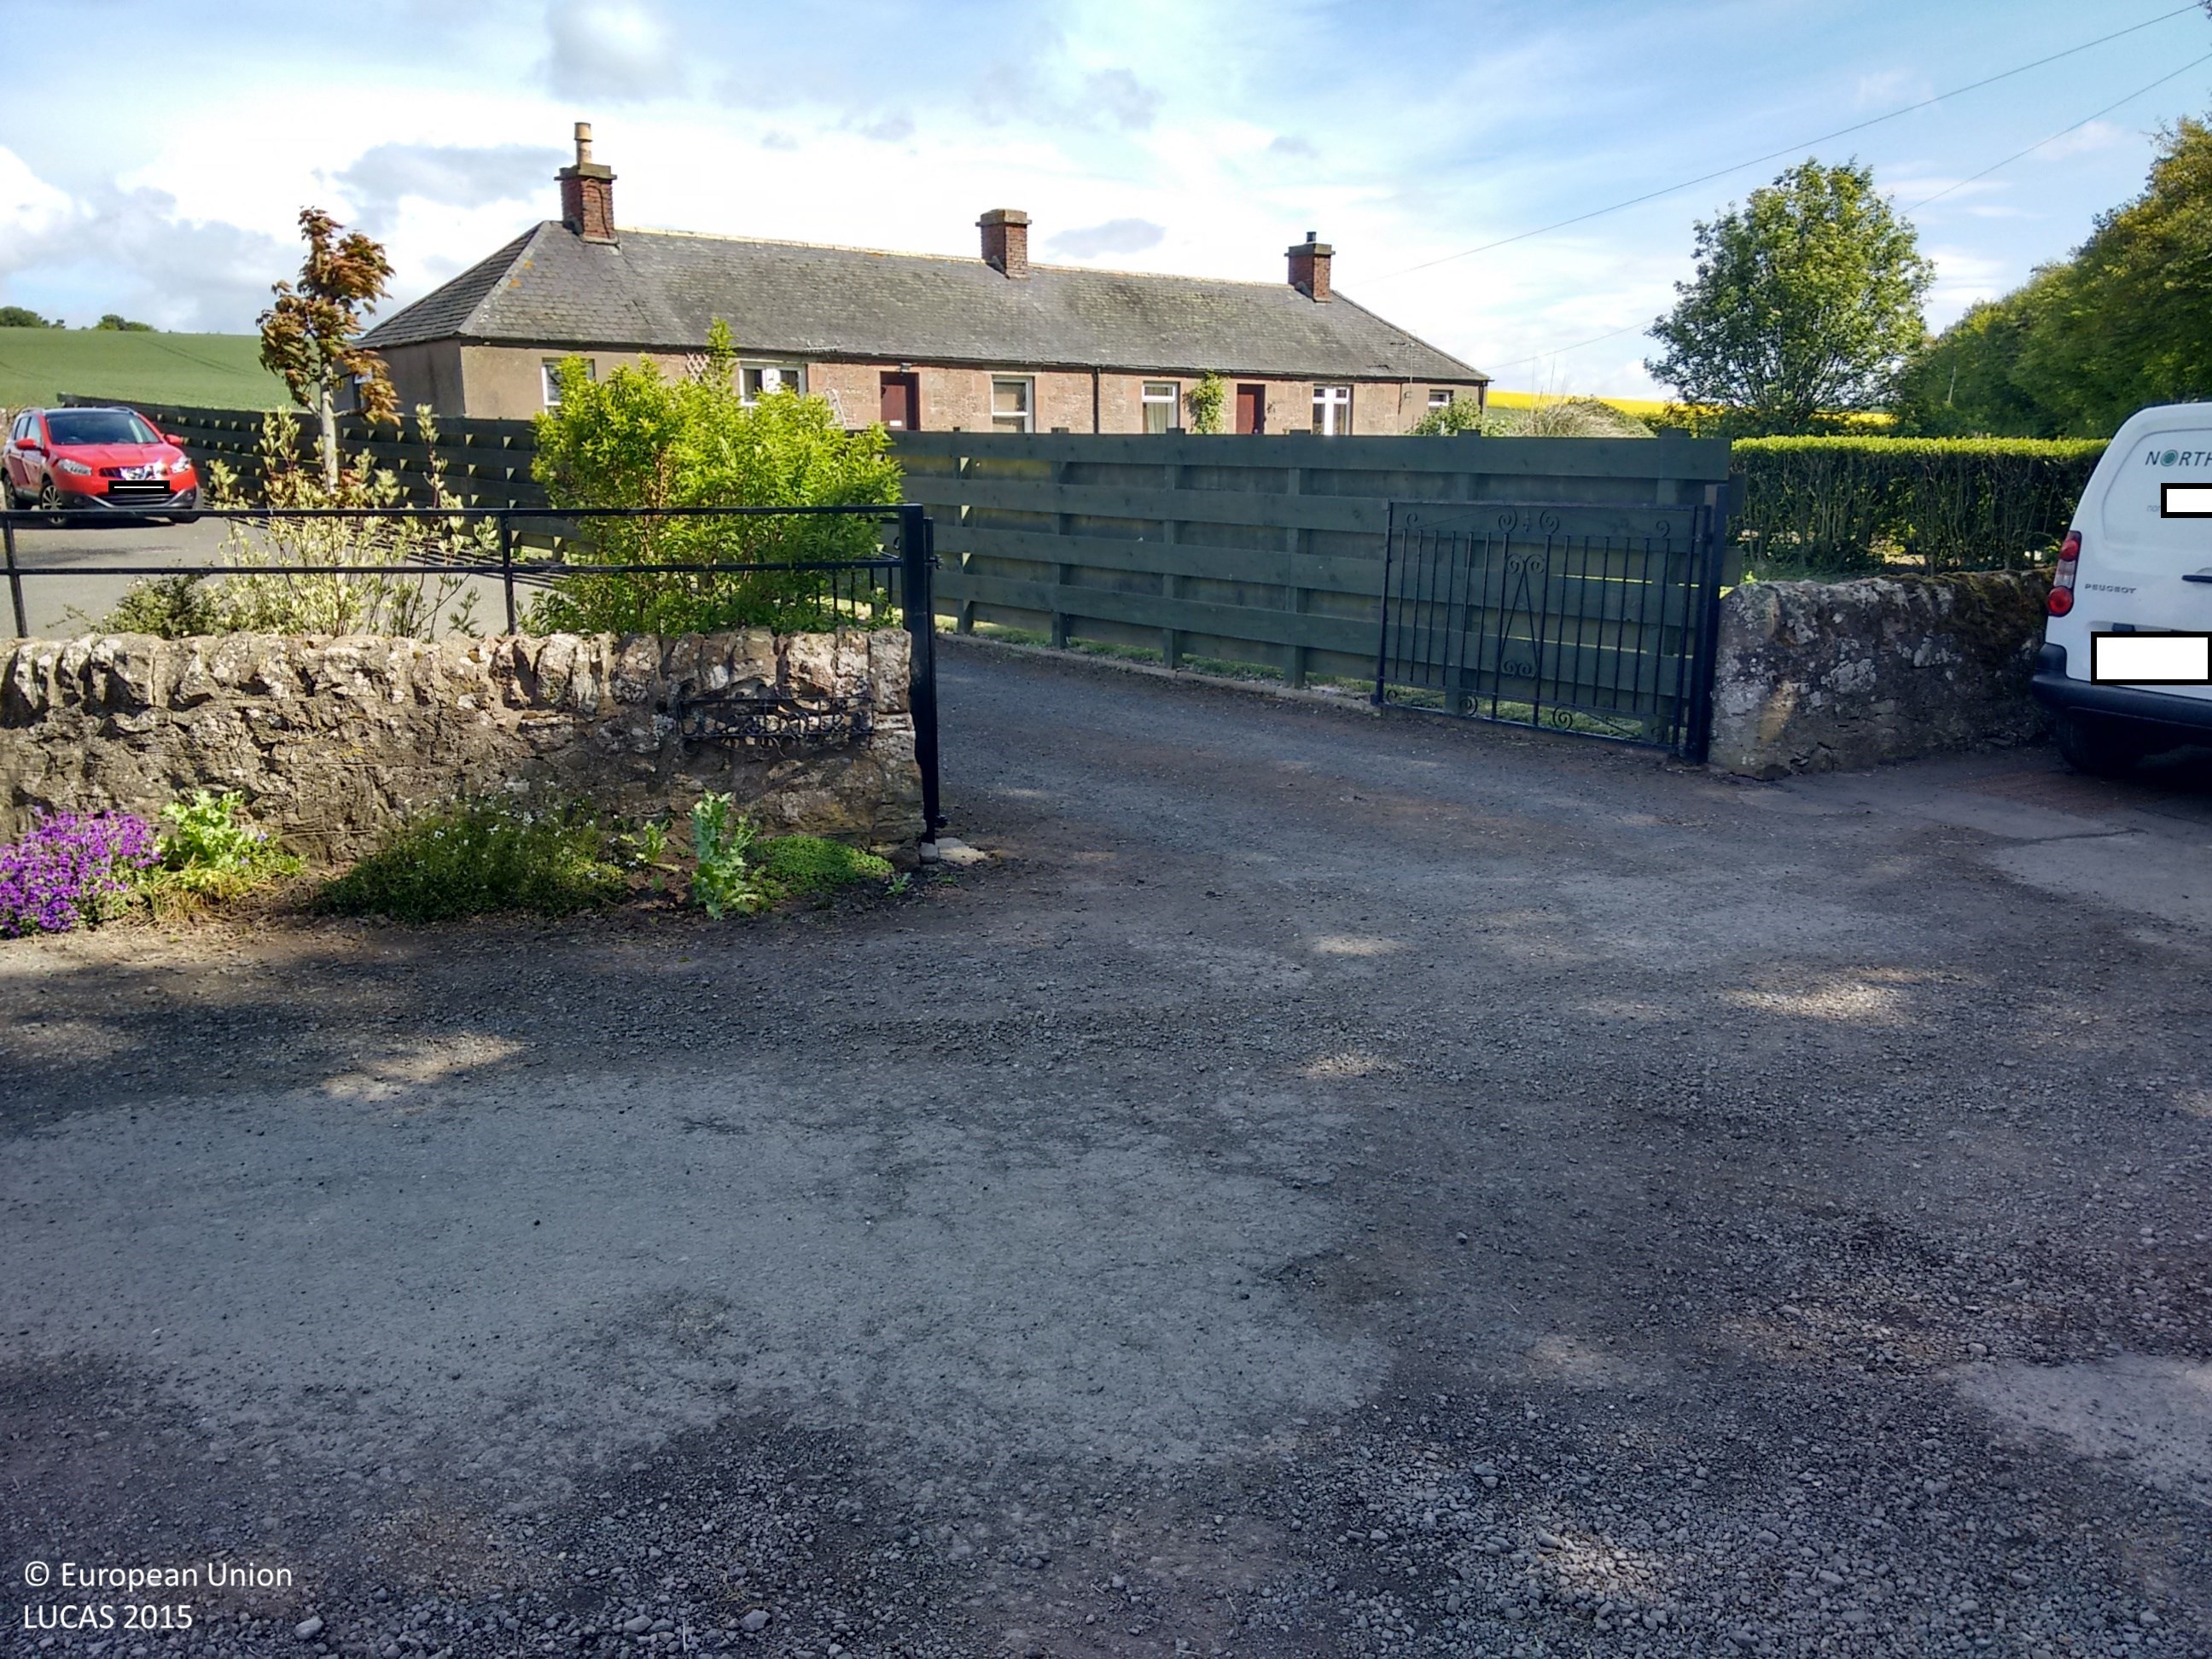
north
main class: Grassland
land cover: Grassland without tree/shrub cover
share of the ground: > 75 %
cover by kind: herbaceous plants 100 %
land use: Agriculture (excluding fallow land and kitchen gardens)
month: May
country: GB
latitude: 56.6568
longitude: -2.6028
